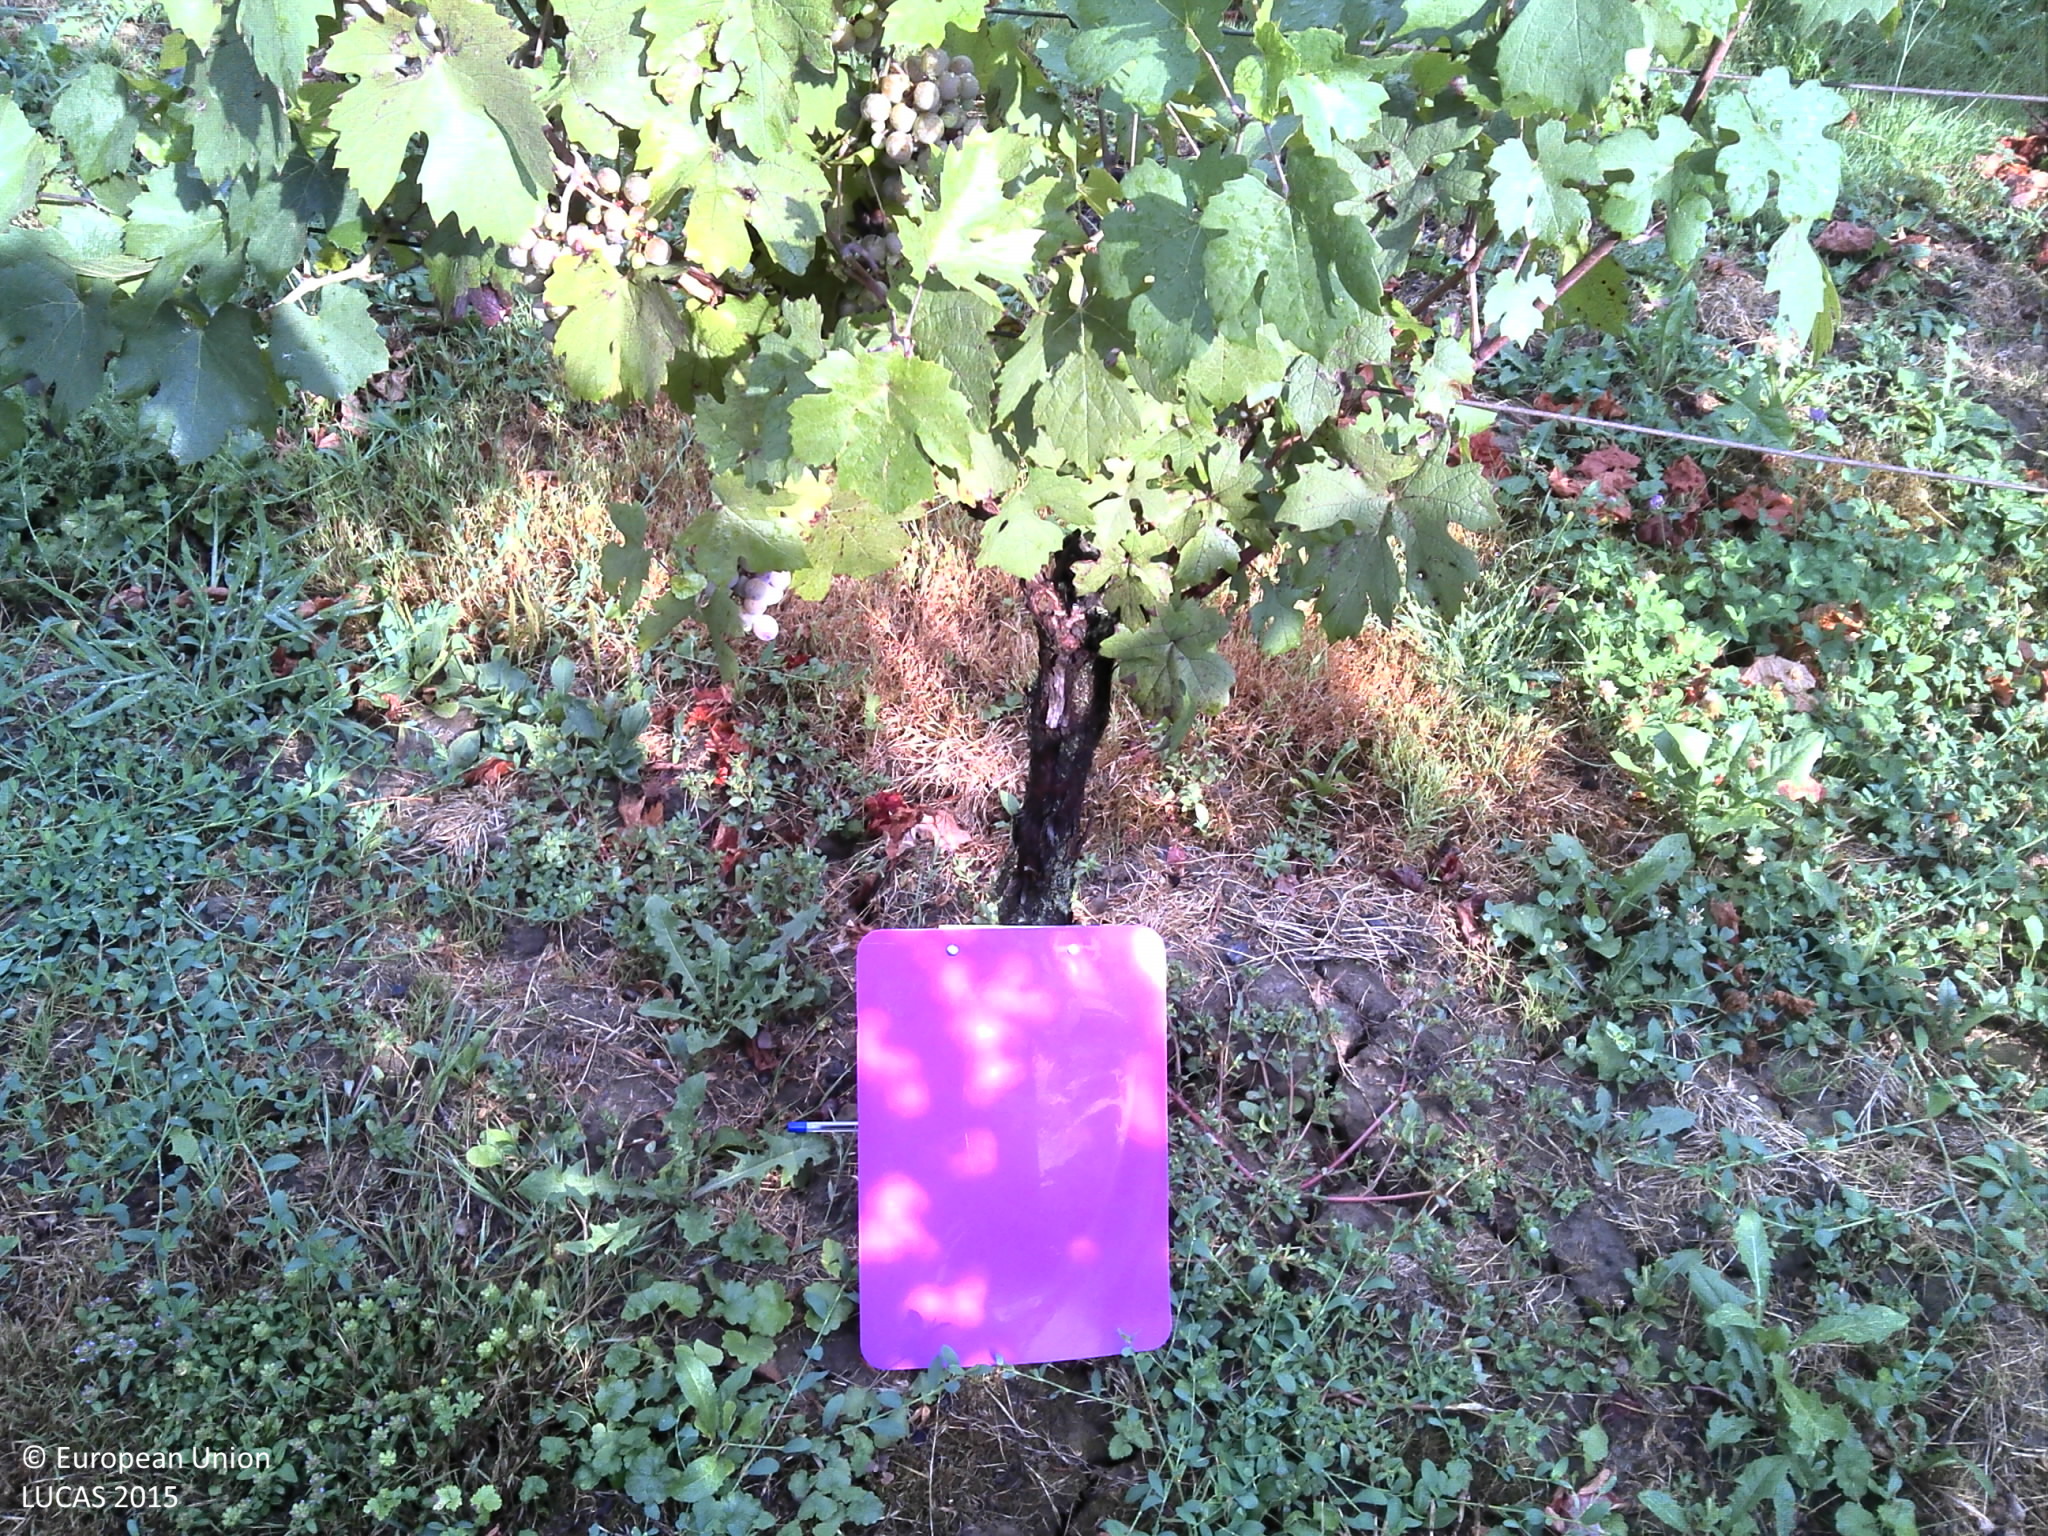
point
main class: Cropland
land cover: Vineyards
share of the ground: 50 - 75 %
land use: Agriculture (excluding fallow land and kitchen gardens)
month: July
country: HR
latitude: 45.5268
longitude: 16.6952
